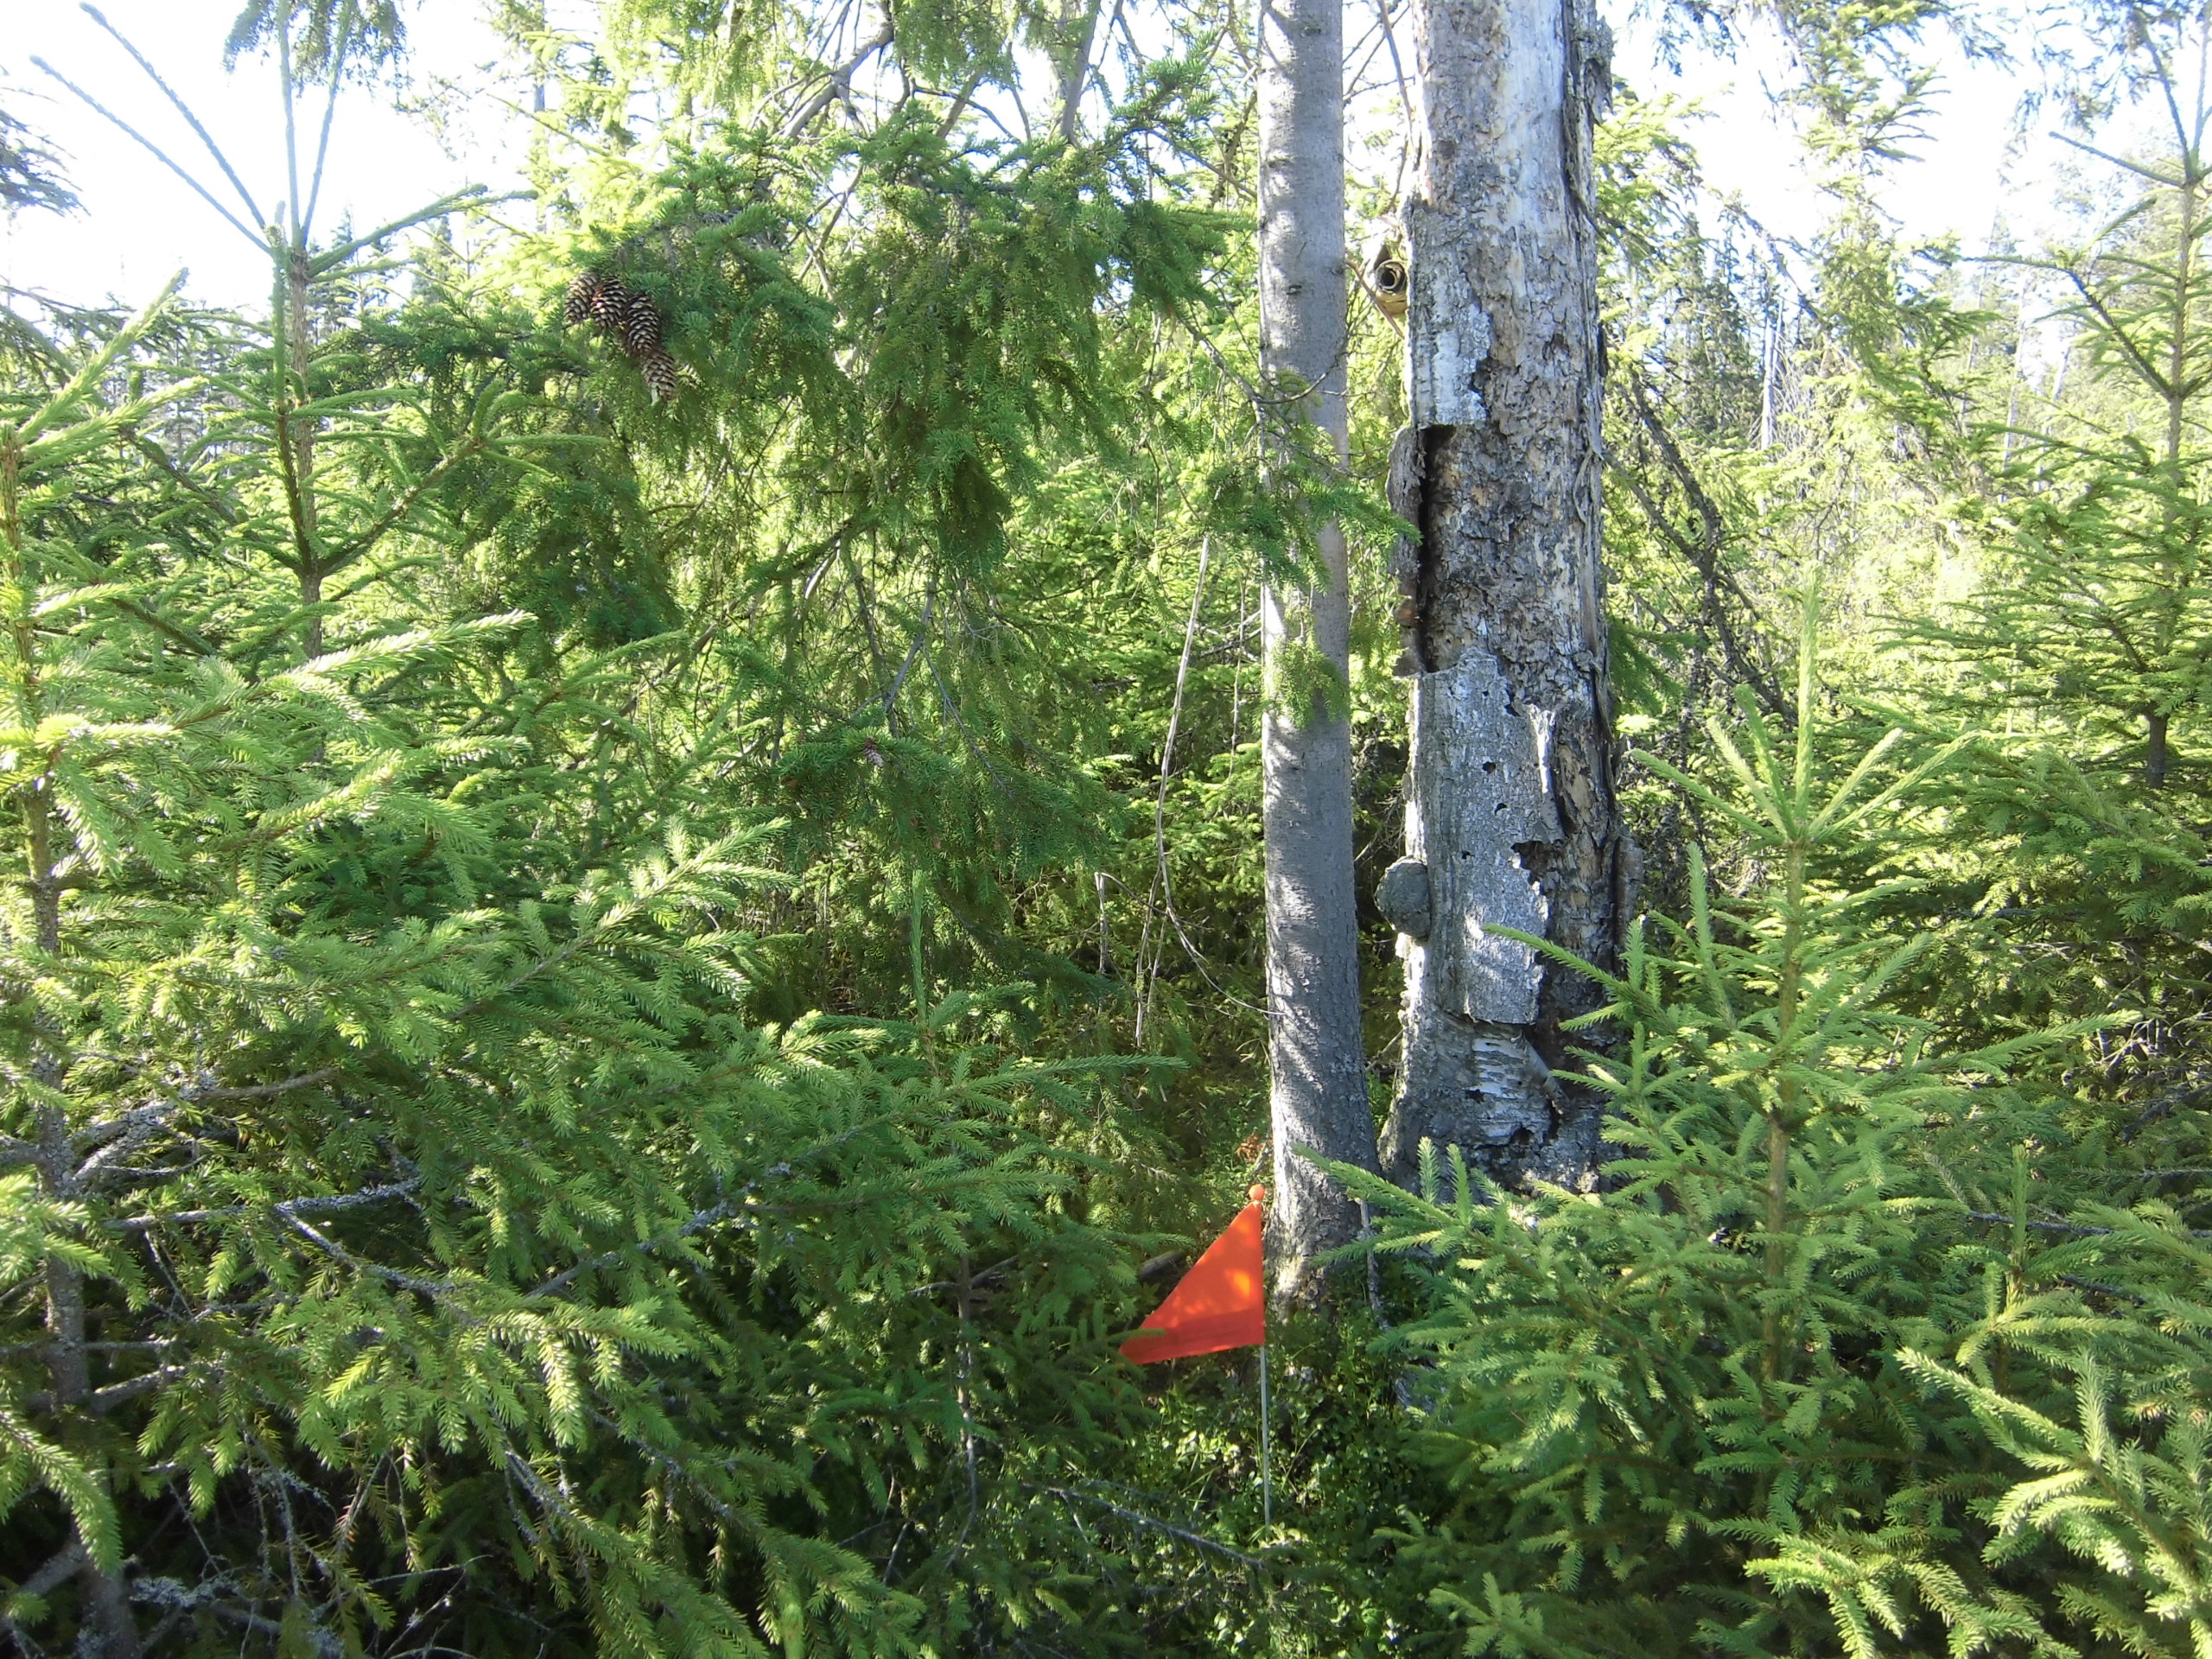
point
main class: Woodland
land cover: Spruce dominated coniferous woodland
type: boreal forest
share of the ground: > 75 %
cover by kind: coniferous forest trees 70 %, broadleaved forest trees 10 %, shrubs 10 %, herbaceous plants 10 %
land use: Forestry
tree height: > 5 m
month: July
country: SE
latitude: 57.2602
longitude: 15.4848
